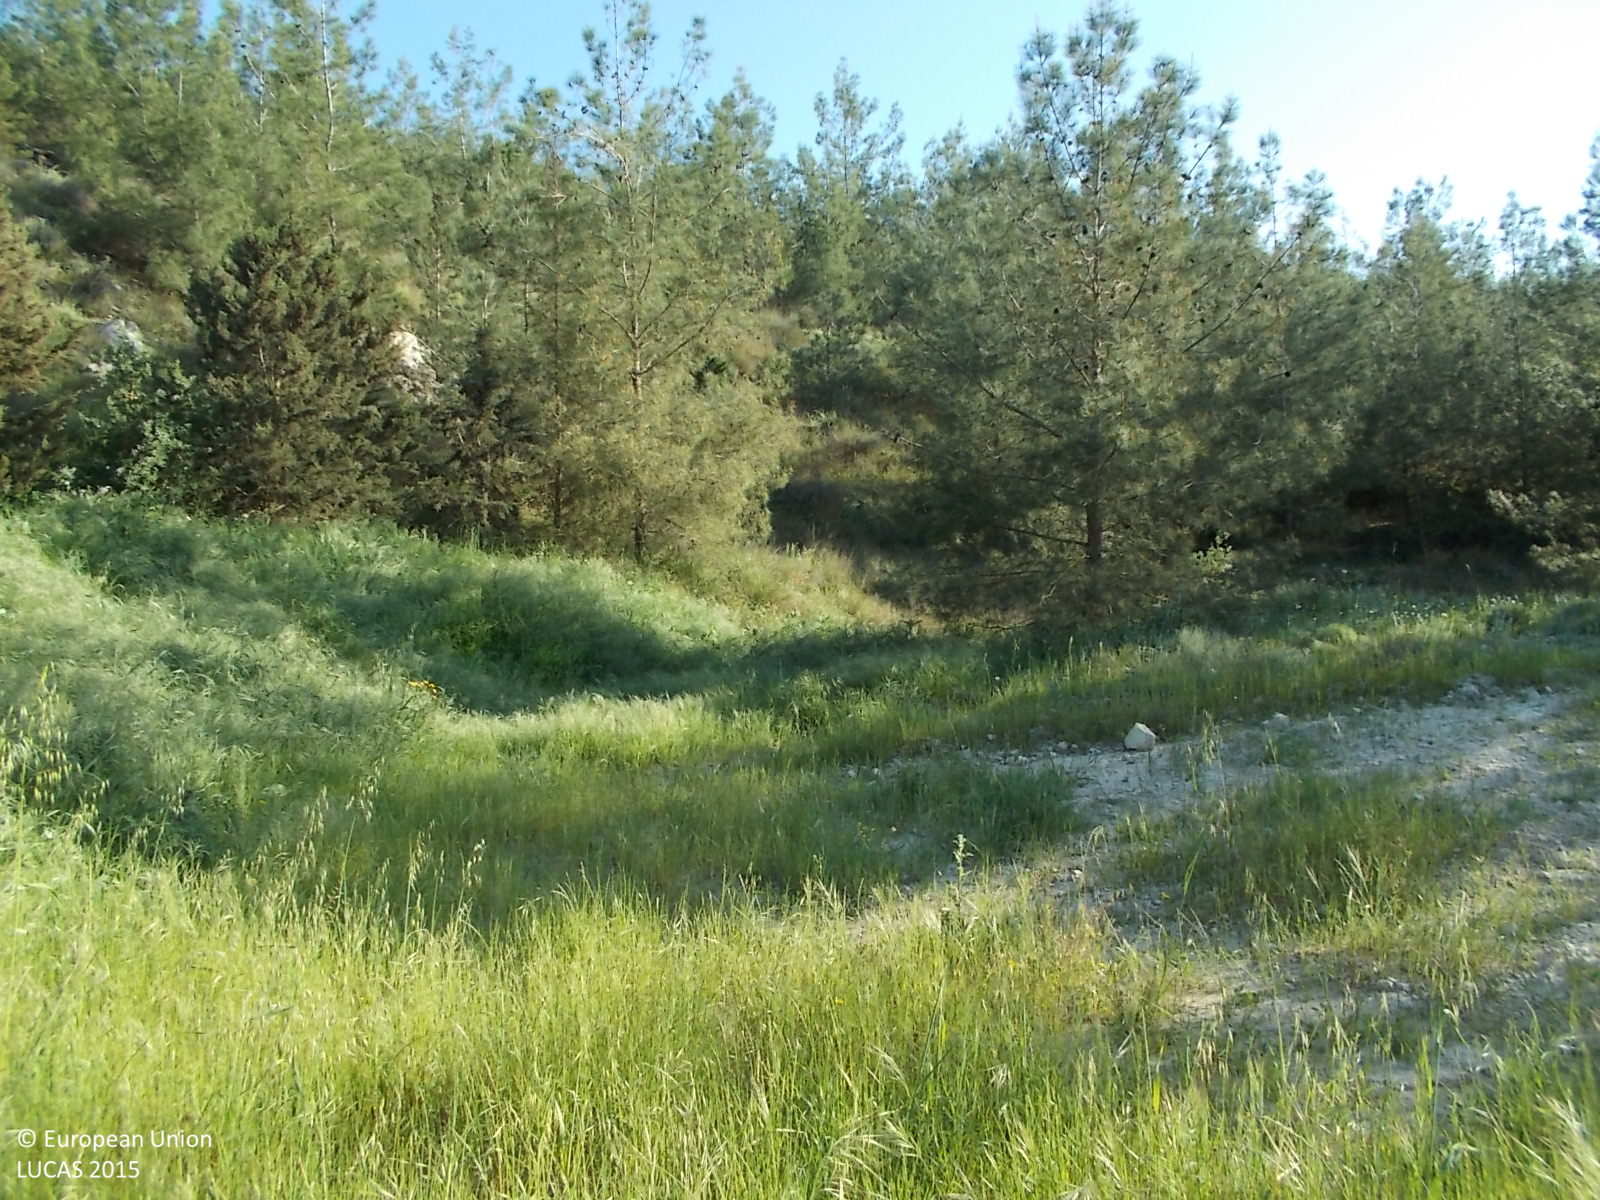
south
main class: Grassland
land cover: Grassland without tree/shrub cover
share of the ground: > 75 %
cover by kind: herbaceous plants 85 %, unconsolidated bare surface 15 %
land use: Semi-natural and natural areas not in use
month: April
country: CY
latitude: 34.9571
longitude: 33.5304
